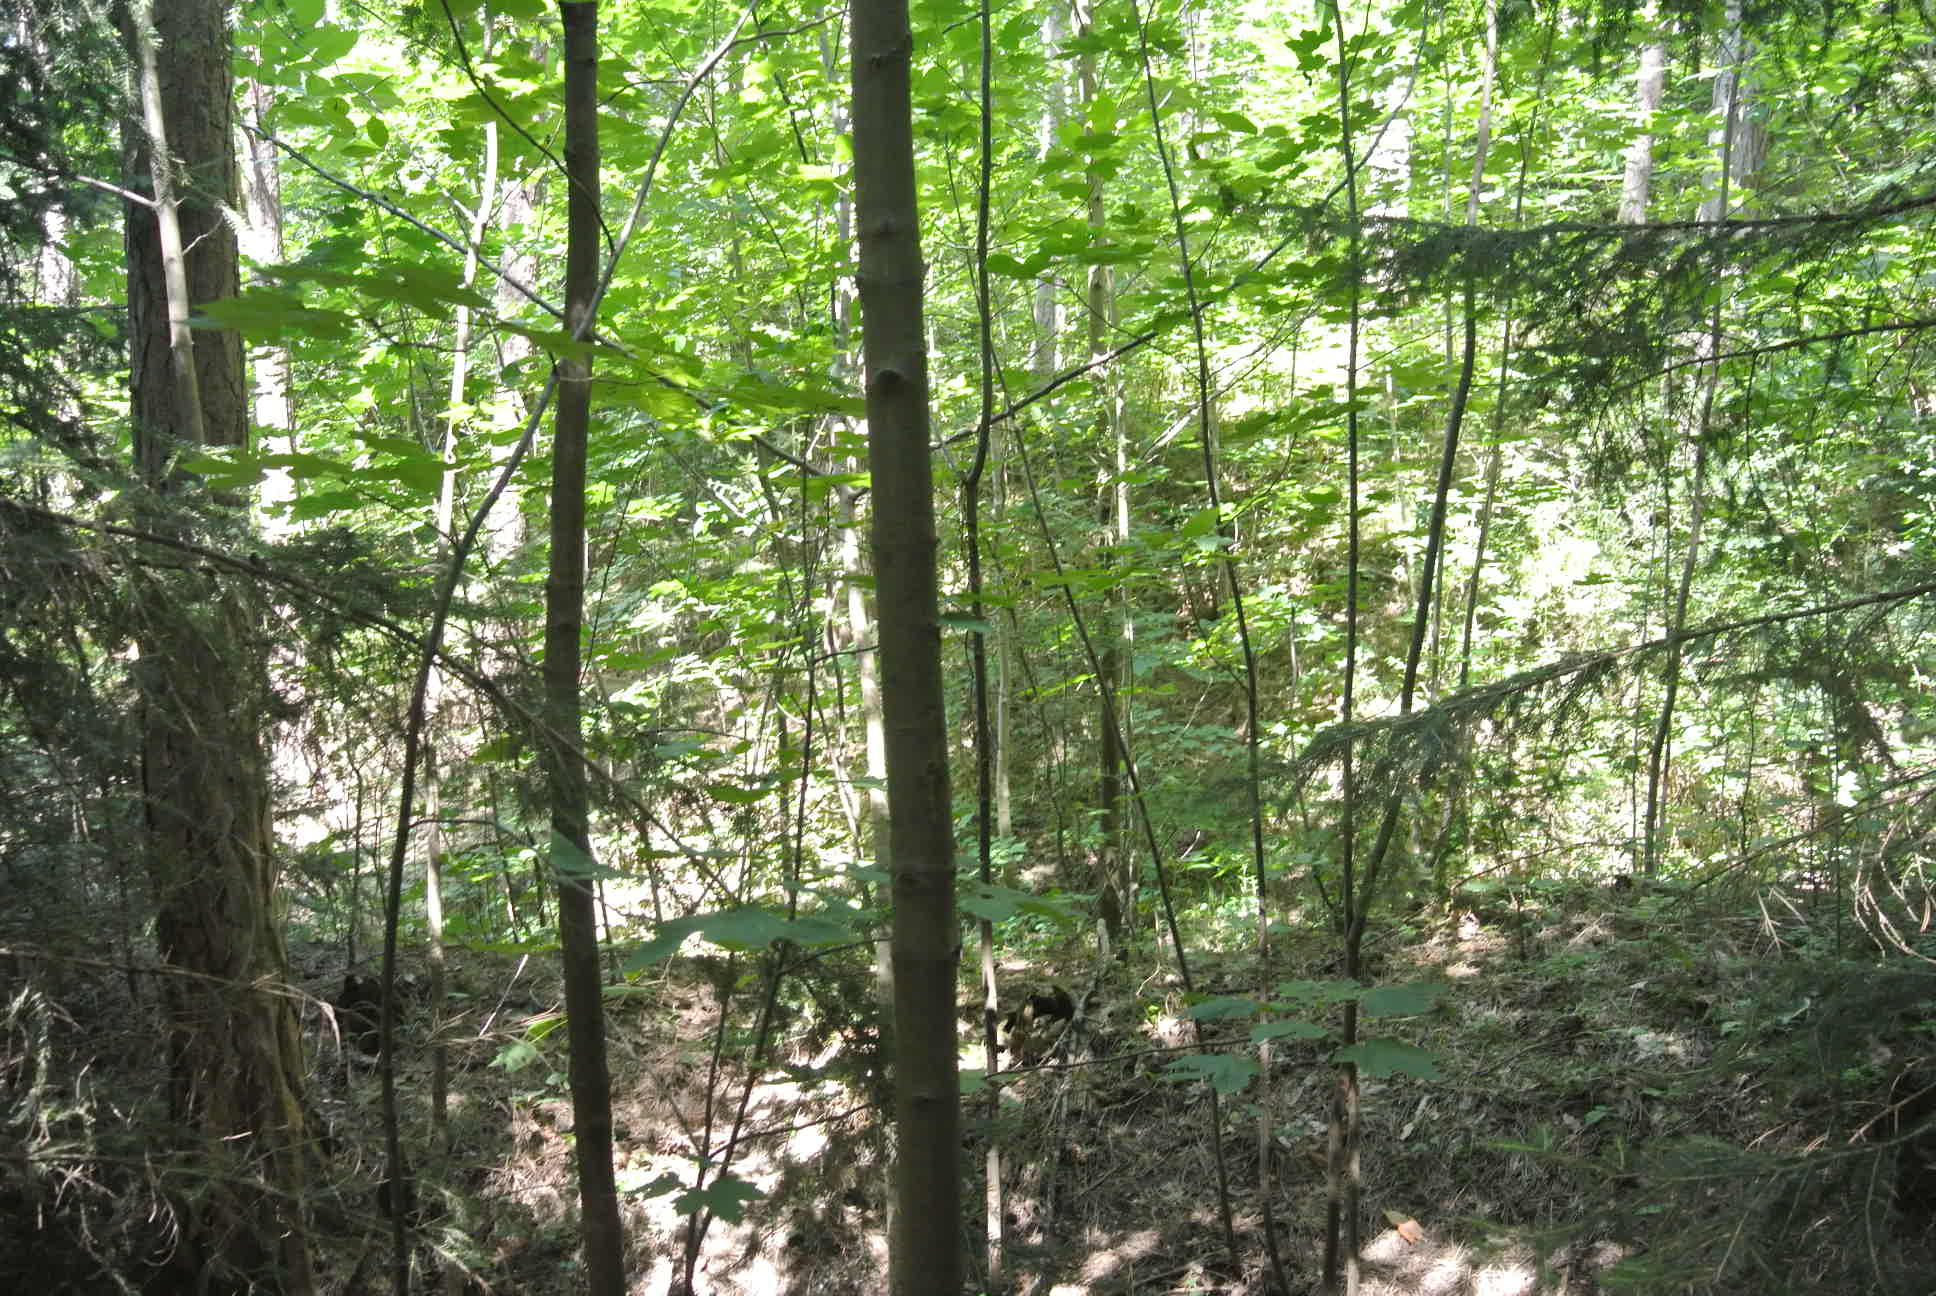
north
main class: Woodland
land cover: Other mixed woodland
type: alpine coniferous forest
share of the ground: > 75 %
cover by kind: coniferous forest trees 70 %, broadleaved forest trees 30 %
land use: Forestry
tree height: > 5 m
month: July
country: AT
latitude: 47.6806
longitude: 16.0103
